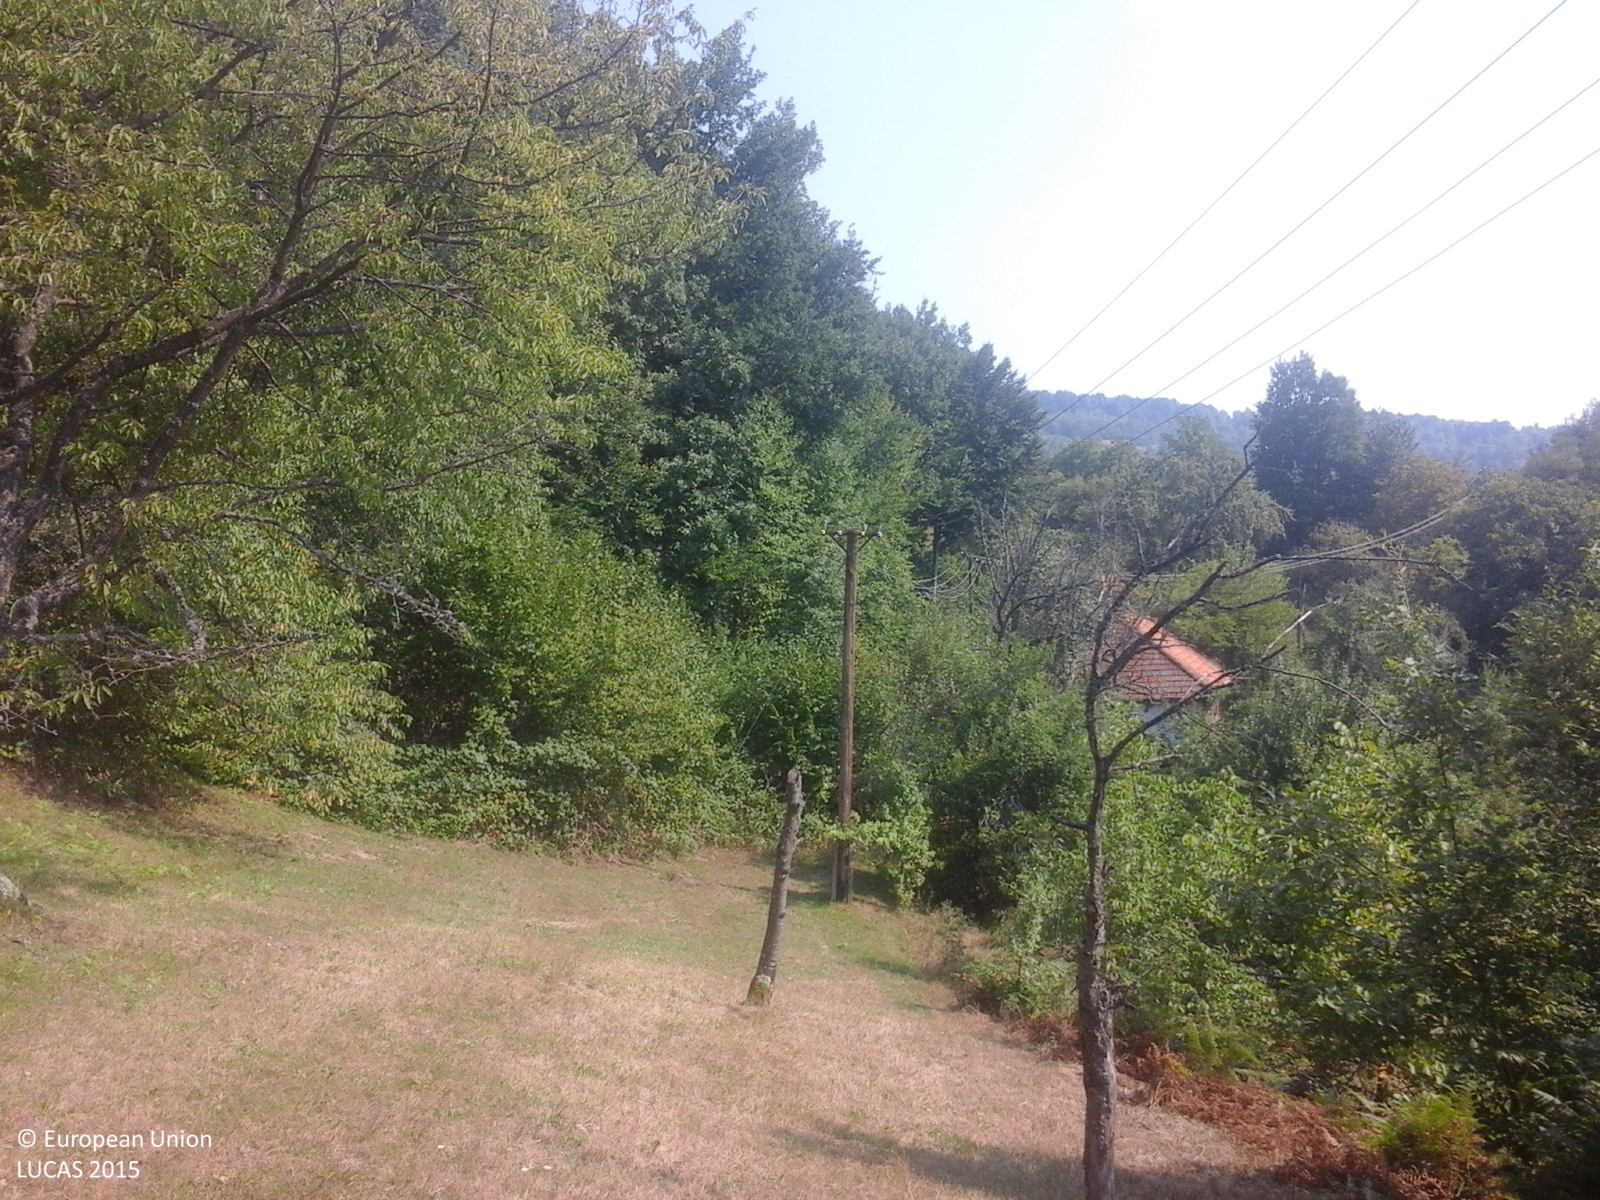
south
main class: Grassland
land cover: Grassland without tree/shrub cover
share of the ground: > 75 %
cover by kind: herbaceous plants 100 %
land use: Agriculture (excluding fallow land and kitchen gardens)
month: August
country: RO
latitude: 46.3507
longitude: 22.5919
